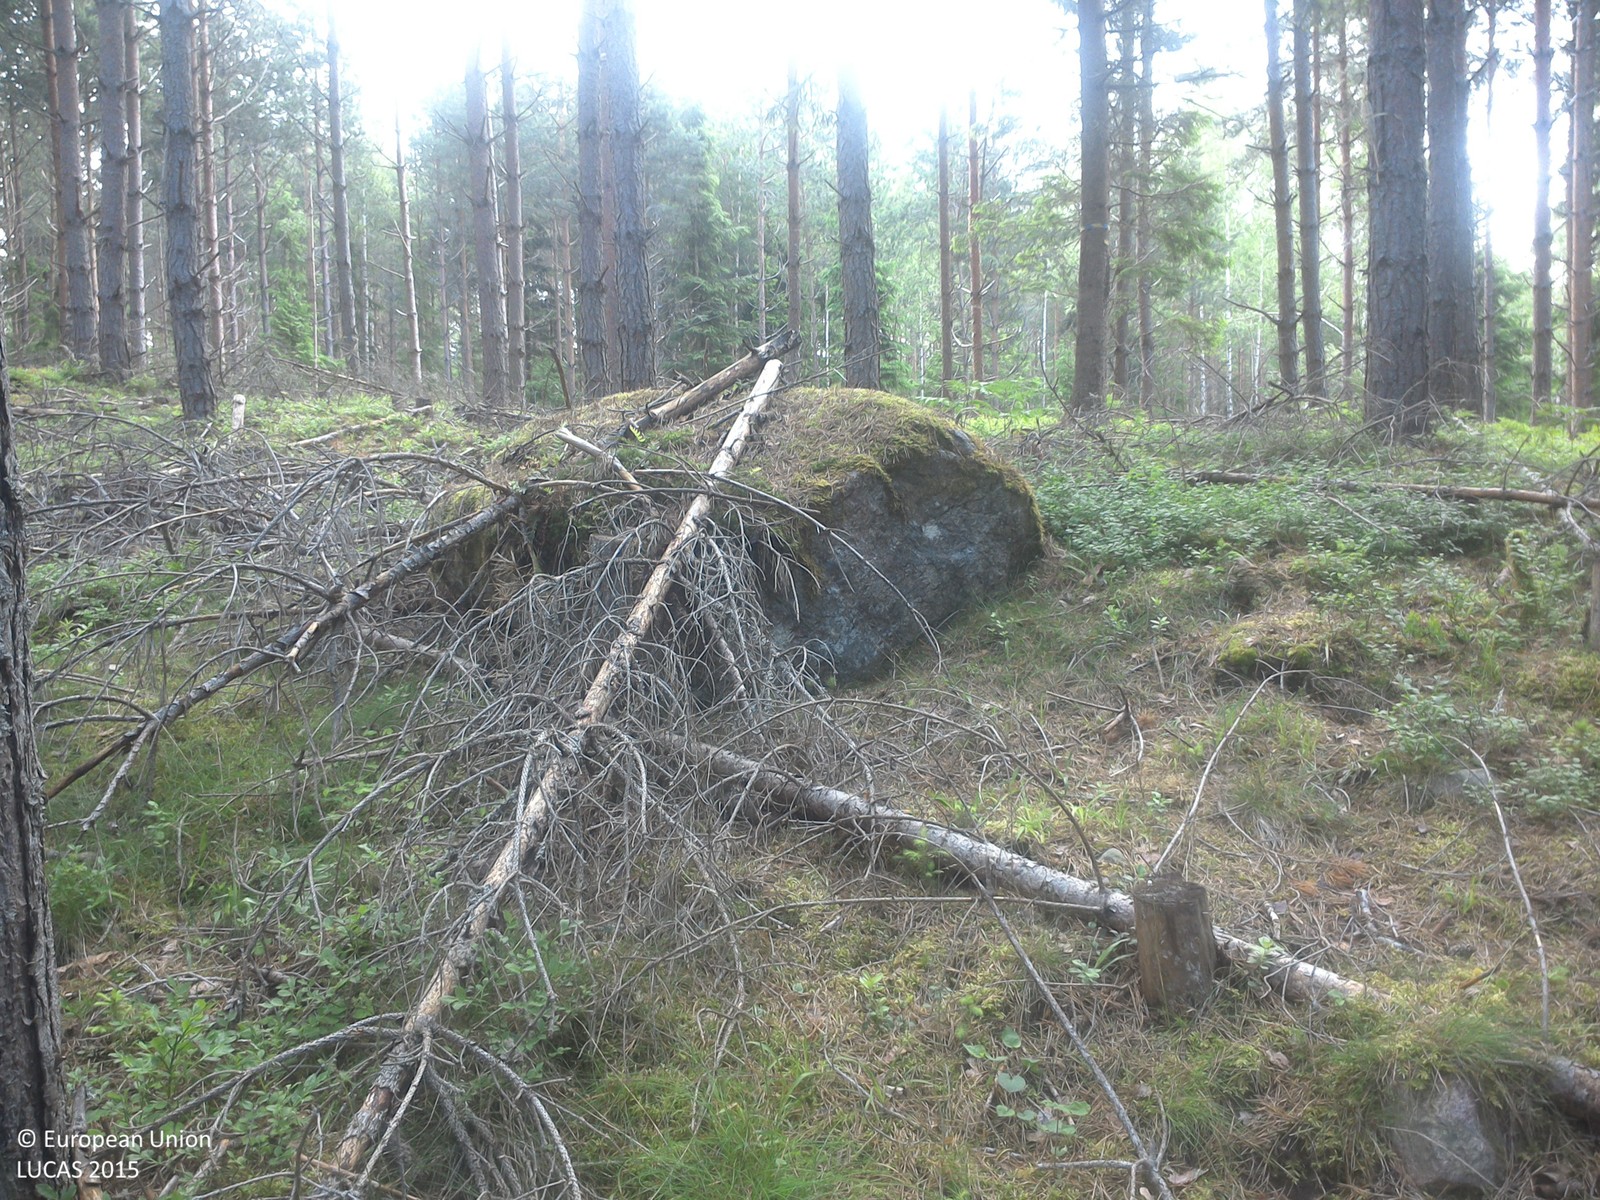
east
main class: Woodland
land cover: Pine dominated coniferous woodland
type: boreal forest
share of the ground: 50 - 75 %
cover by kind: coniferous forest trees 55 %, lichens and mosses 25 %, herbaceous plants 20 %
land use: Forestry
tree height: > 5 m
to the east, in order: Pine dominated coniferous woodland; Spruce dominated coniferous woodland; Pine dominated mixed woodland; Shrubland with sparse tree cover
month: June
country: SE
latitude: 58.1877
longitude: 15.7272
